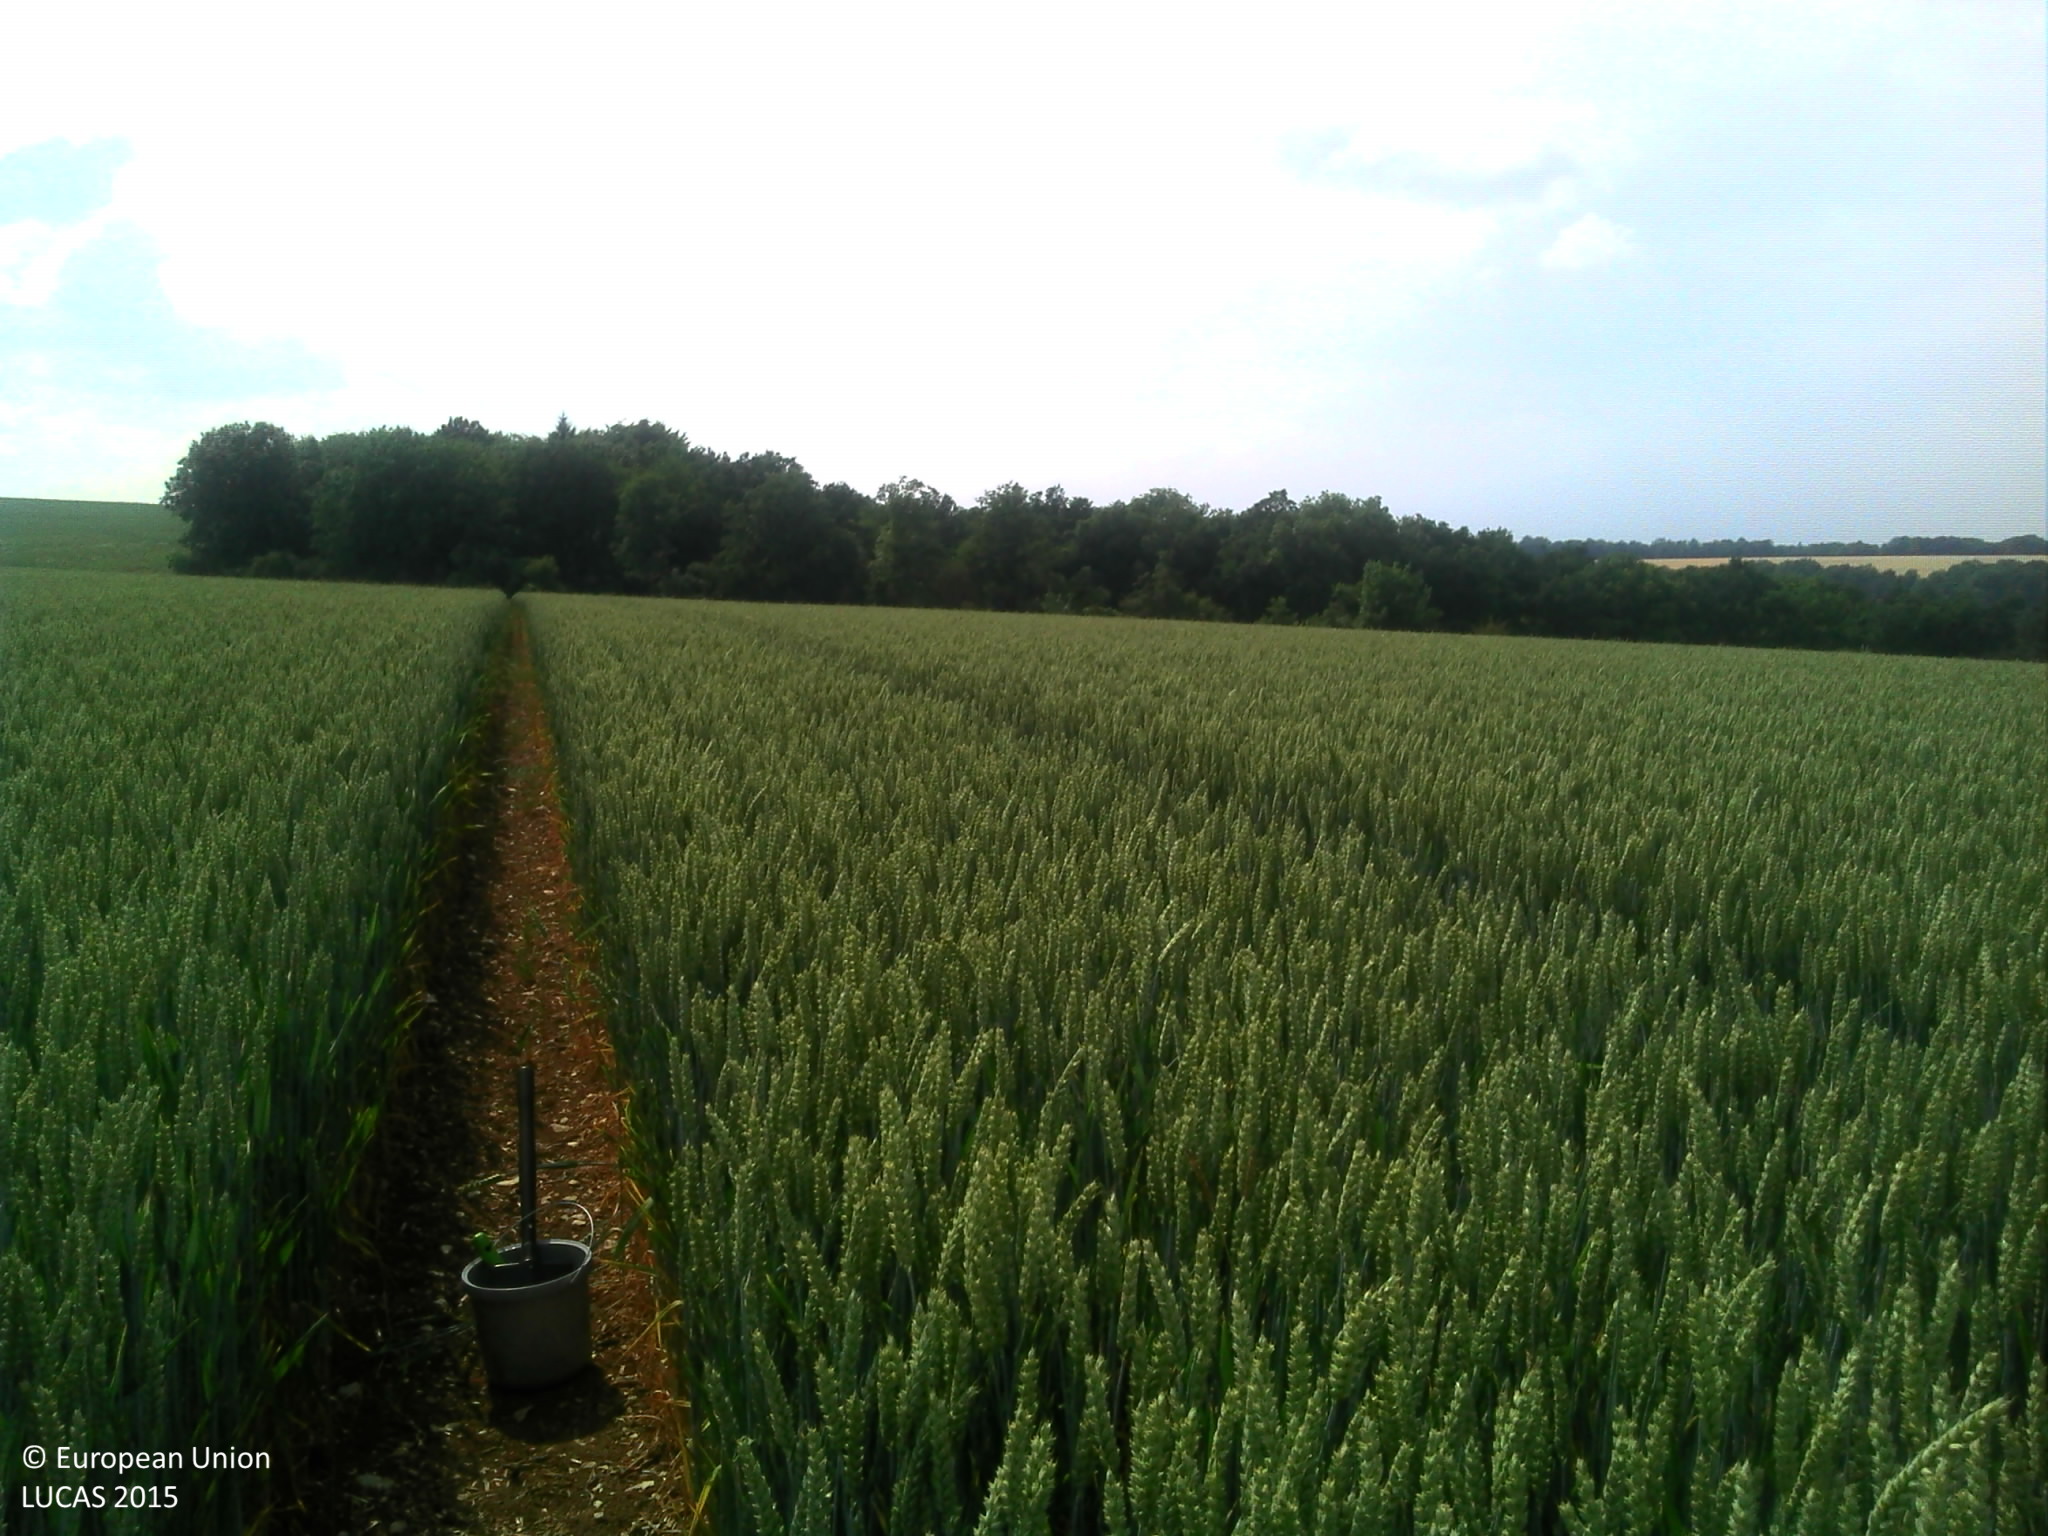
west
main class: Cropland
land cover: Common wheat
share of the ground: > 75 %
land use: Agriculture (excluding fallow land and kitchen gardens)
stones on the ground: 10 - 25 %
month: June
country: FR
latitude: 48.3058
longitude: 4.9427
